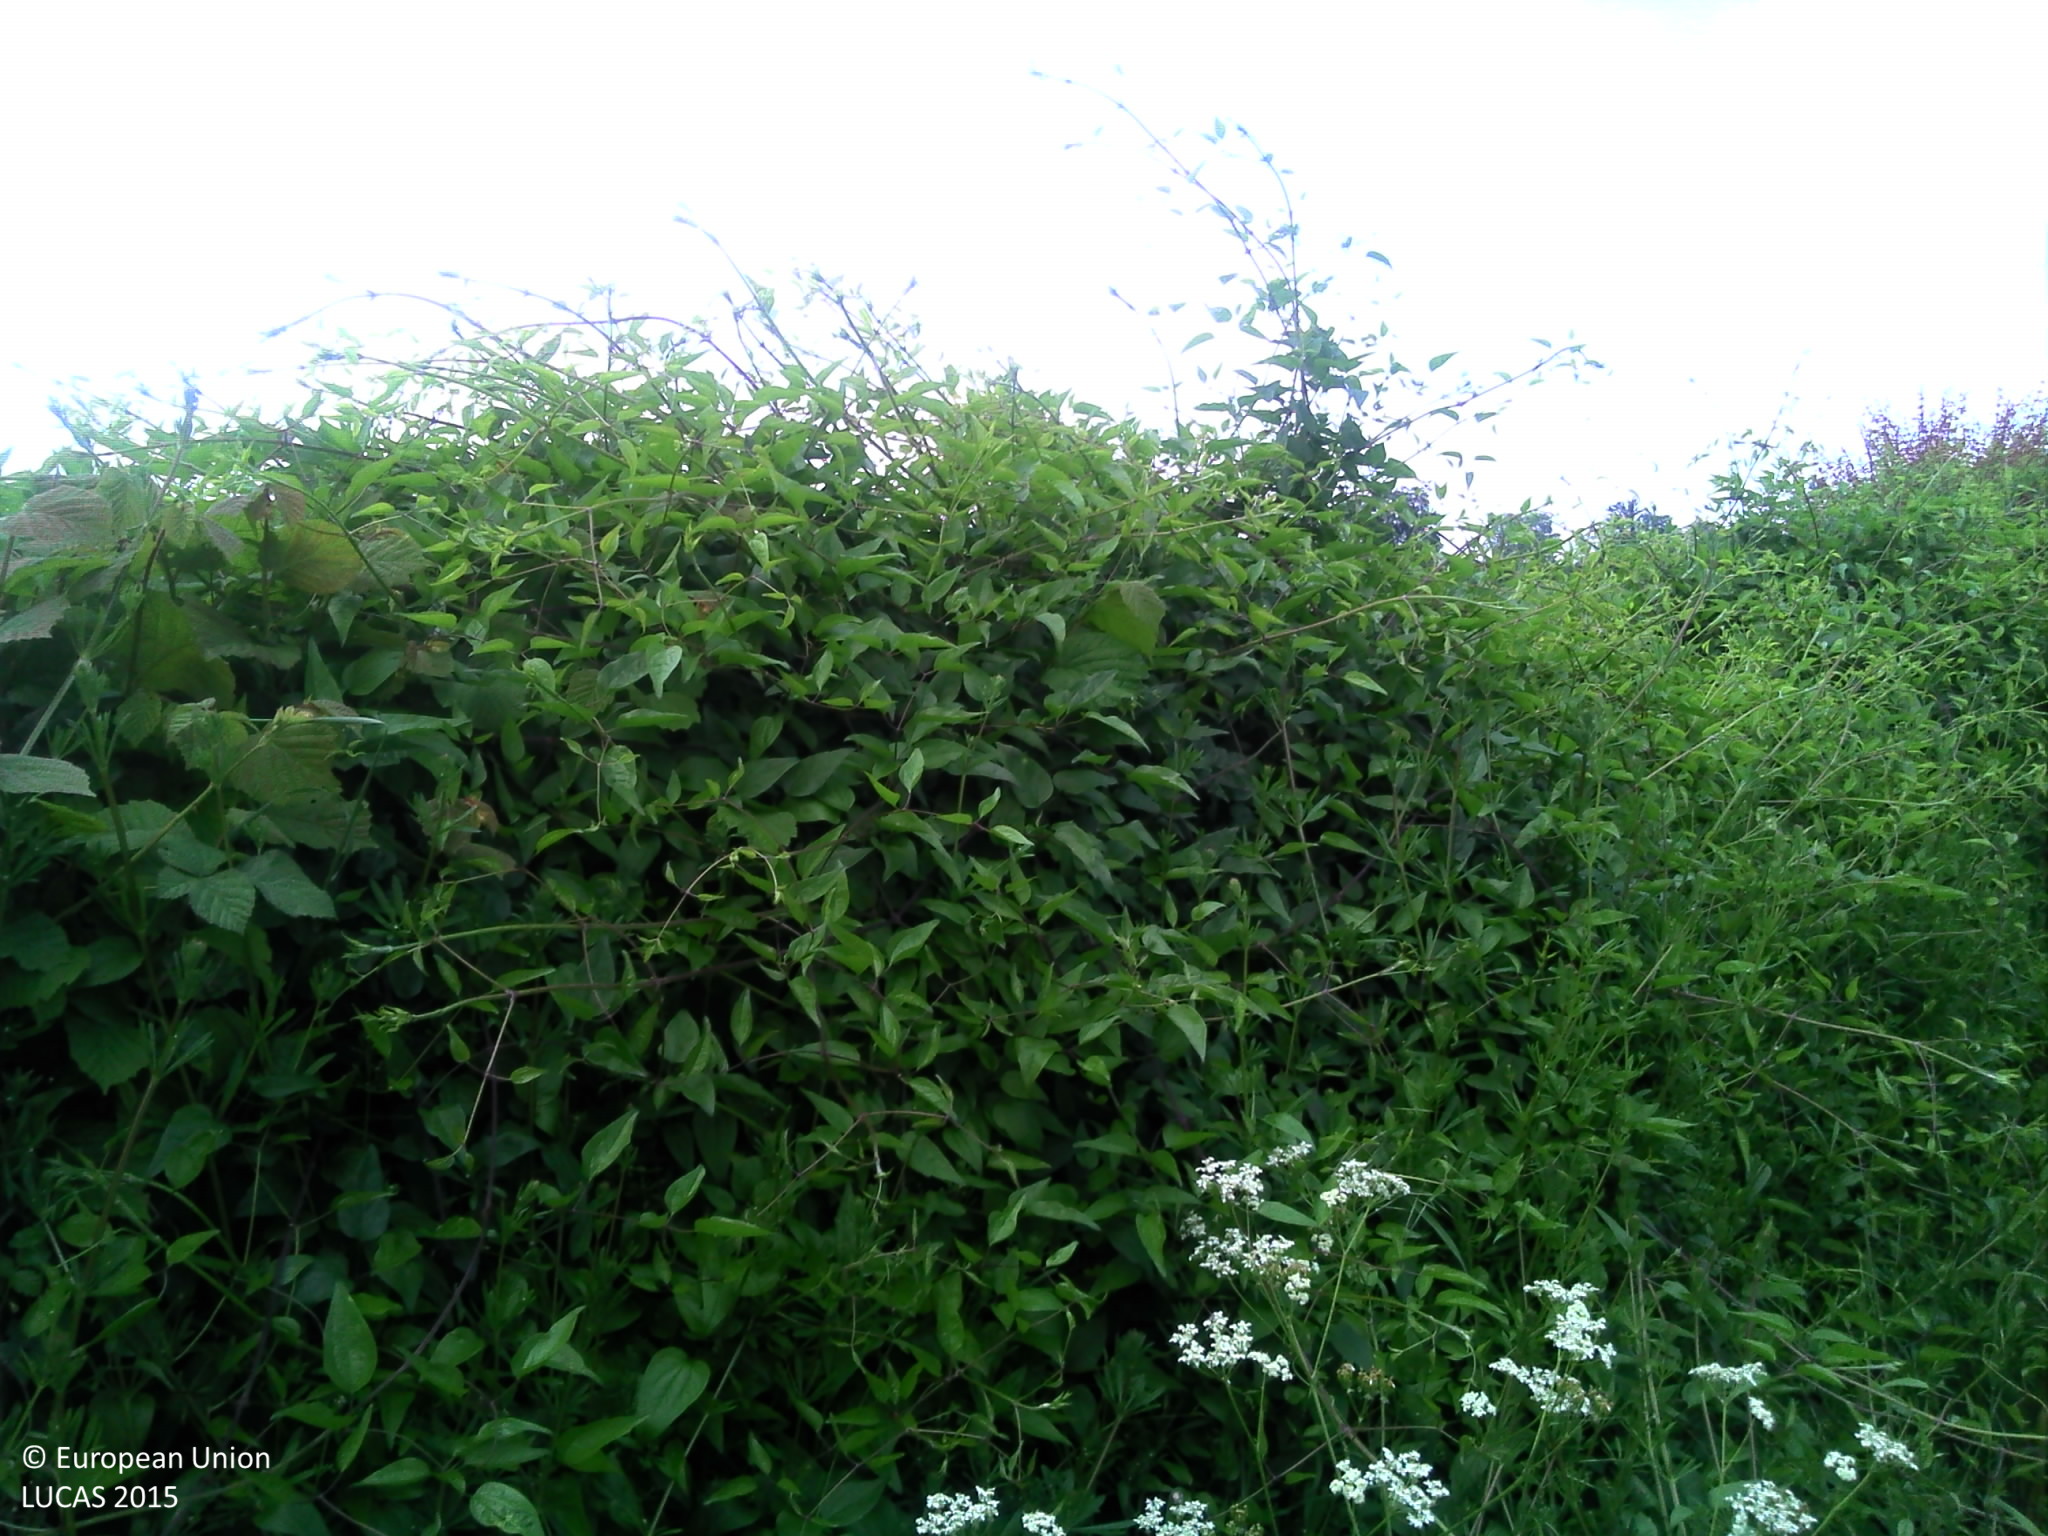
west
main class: Cropland
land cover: Rape and turnip rape
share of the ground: > 75 %
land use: Agriculture (excluding fallow land and kitchen gardens)
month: May
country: FR
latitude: 48.7677
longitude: -0.1681
